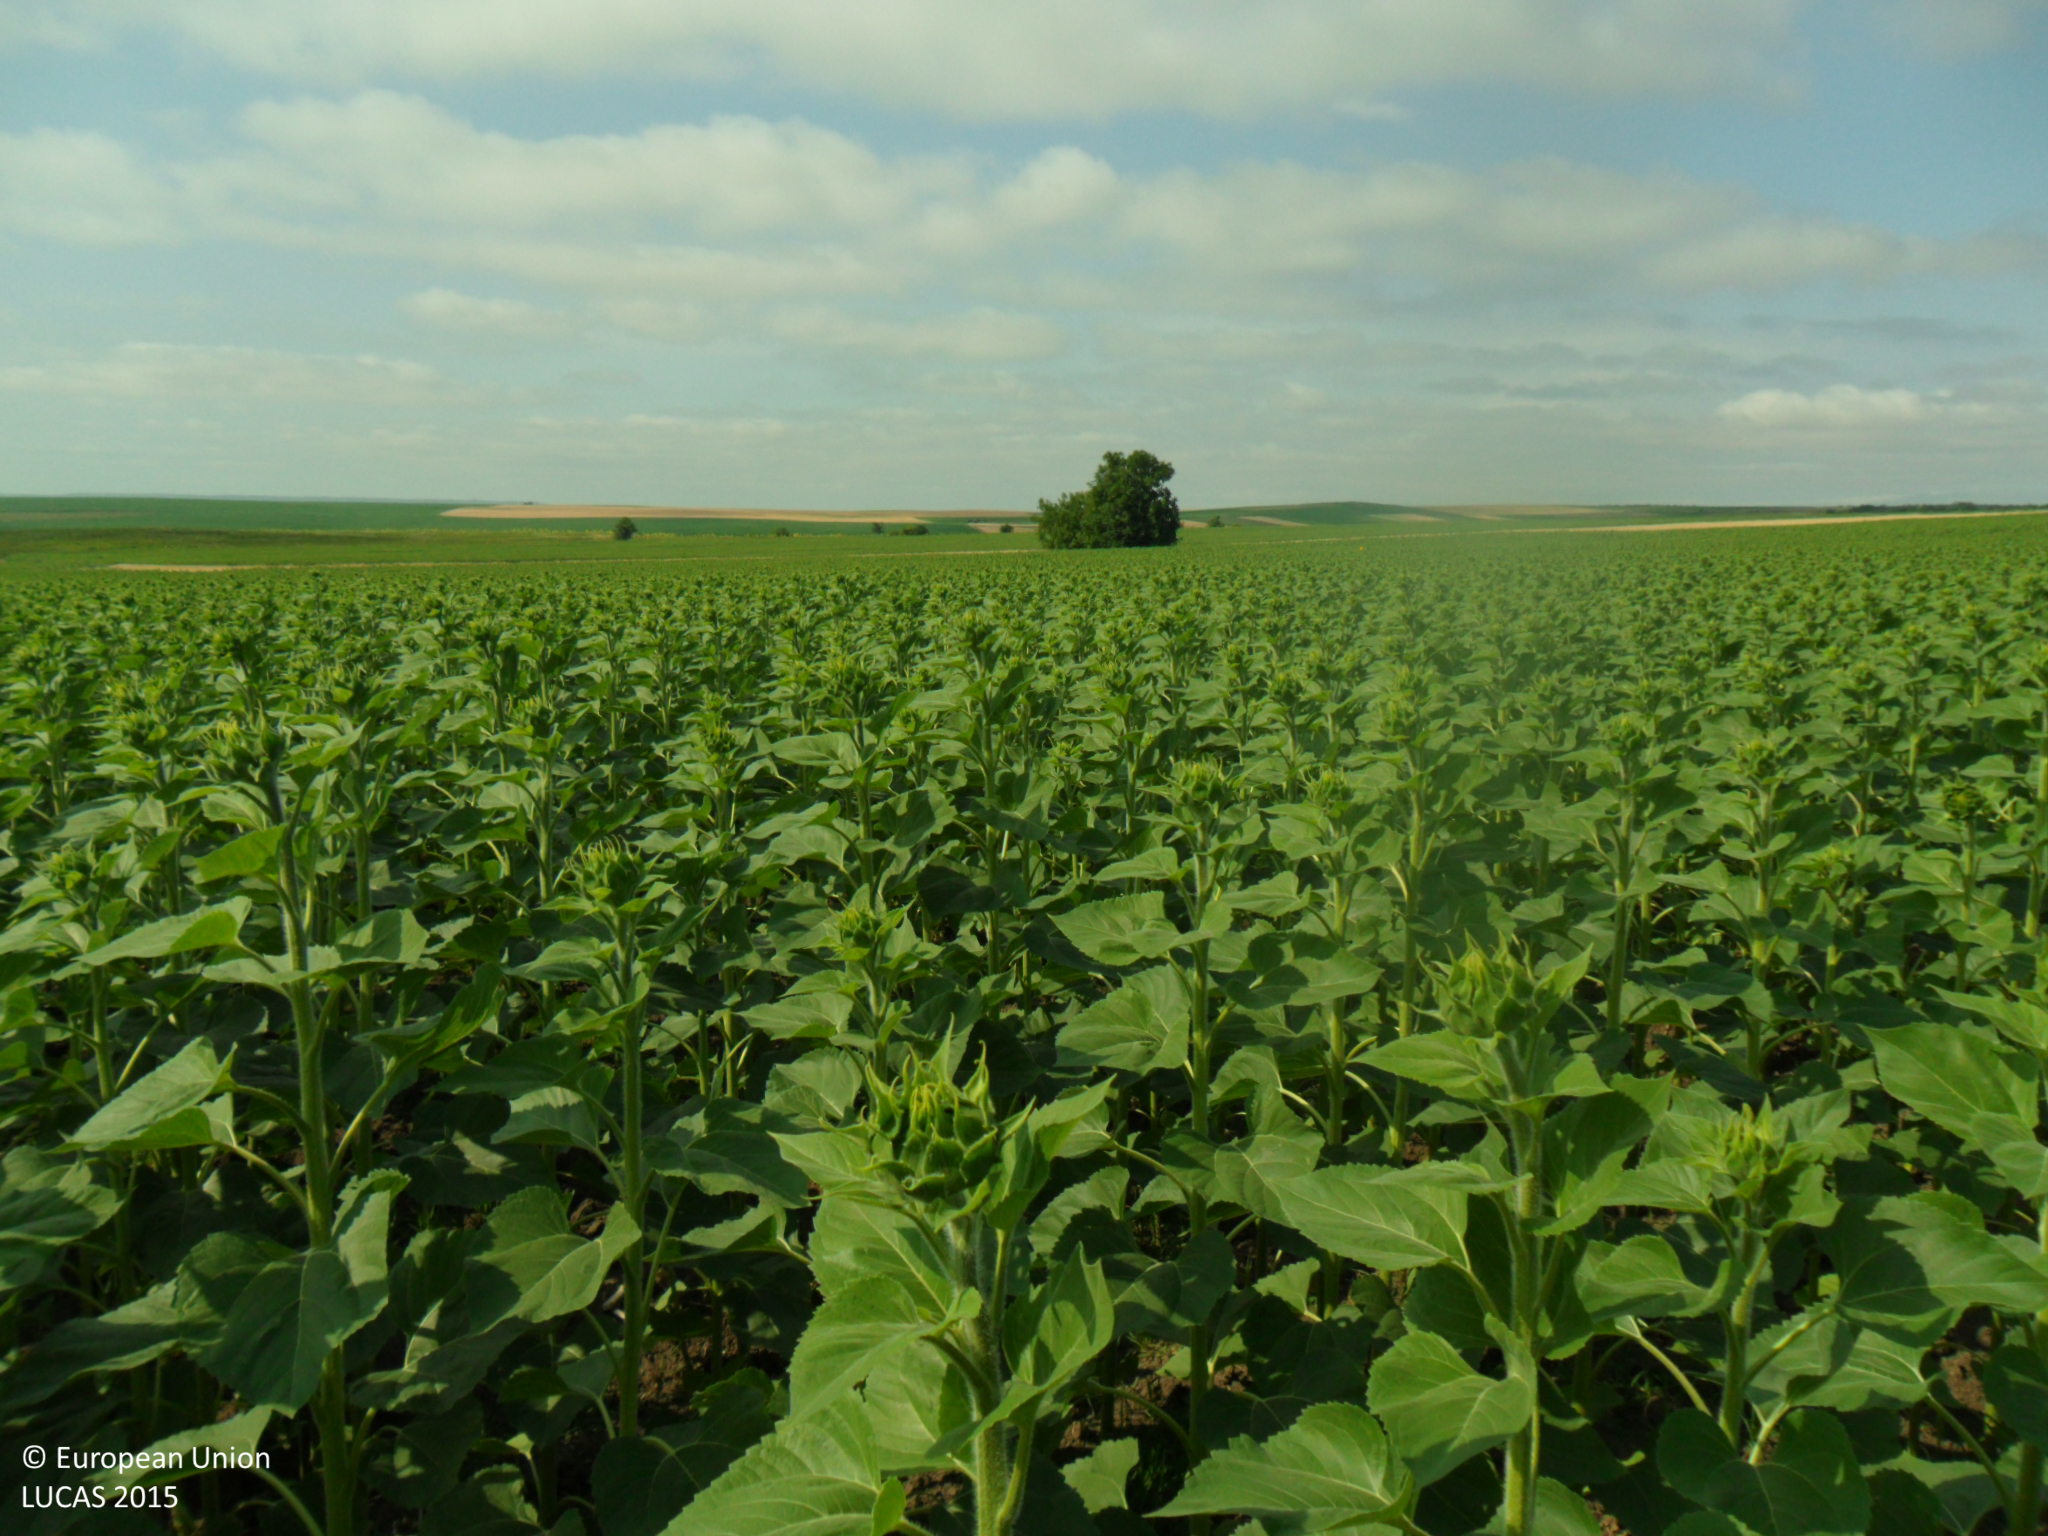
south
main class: Cropland
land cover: Sunflower
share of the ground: > 75 %
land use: Agriculture (excluding fallow land and kitchen gardens)
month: June
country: BG
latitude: 43.4461
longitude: 27.1352
